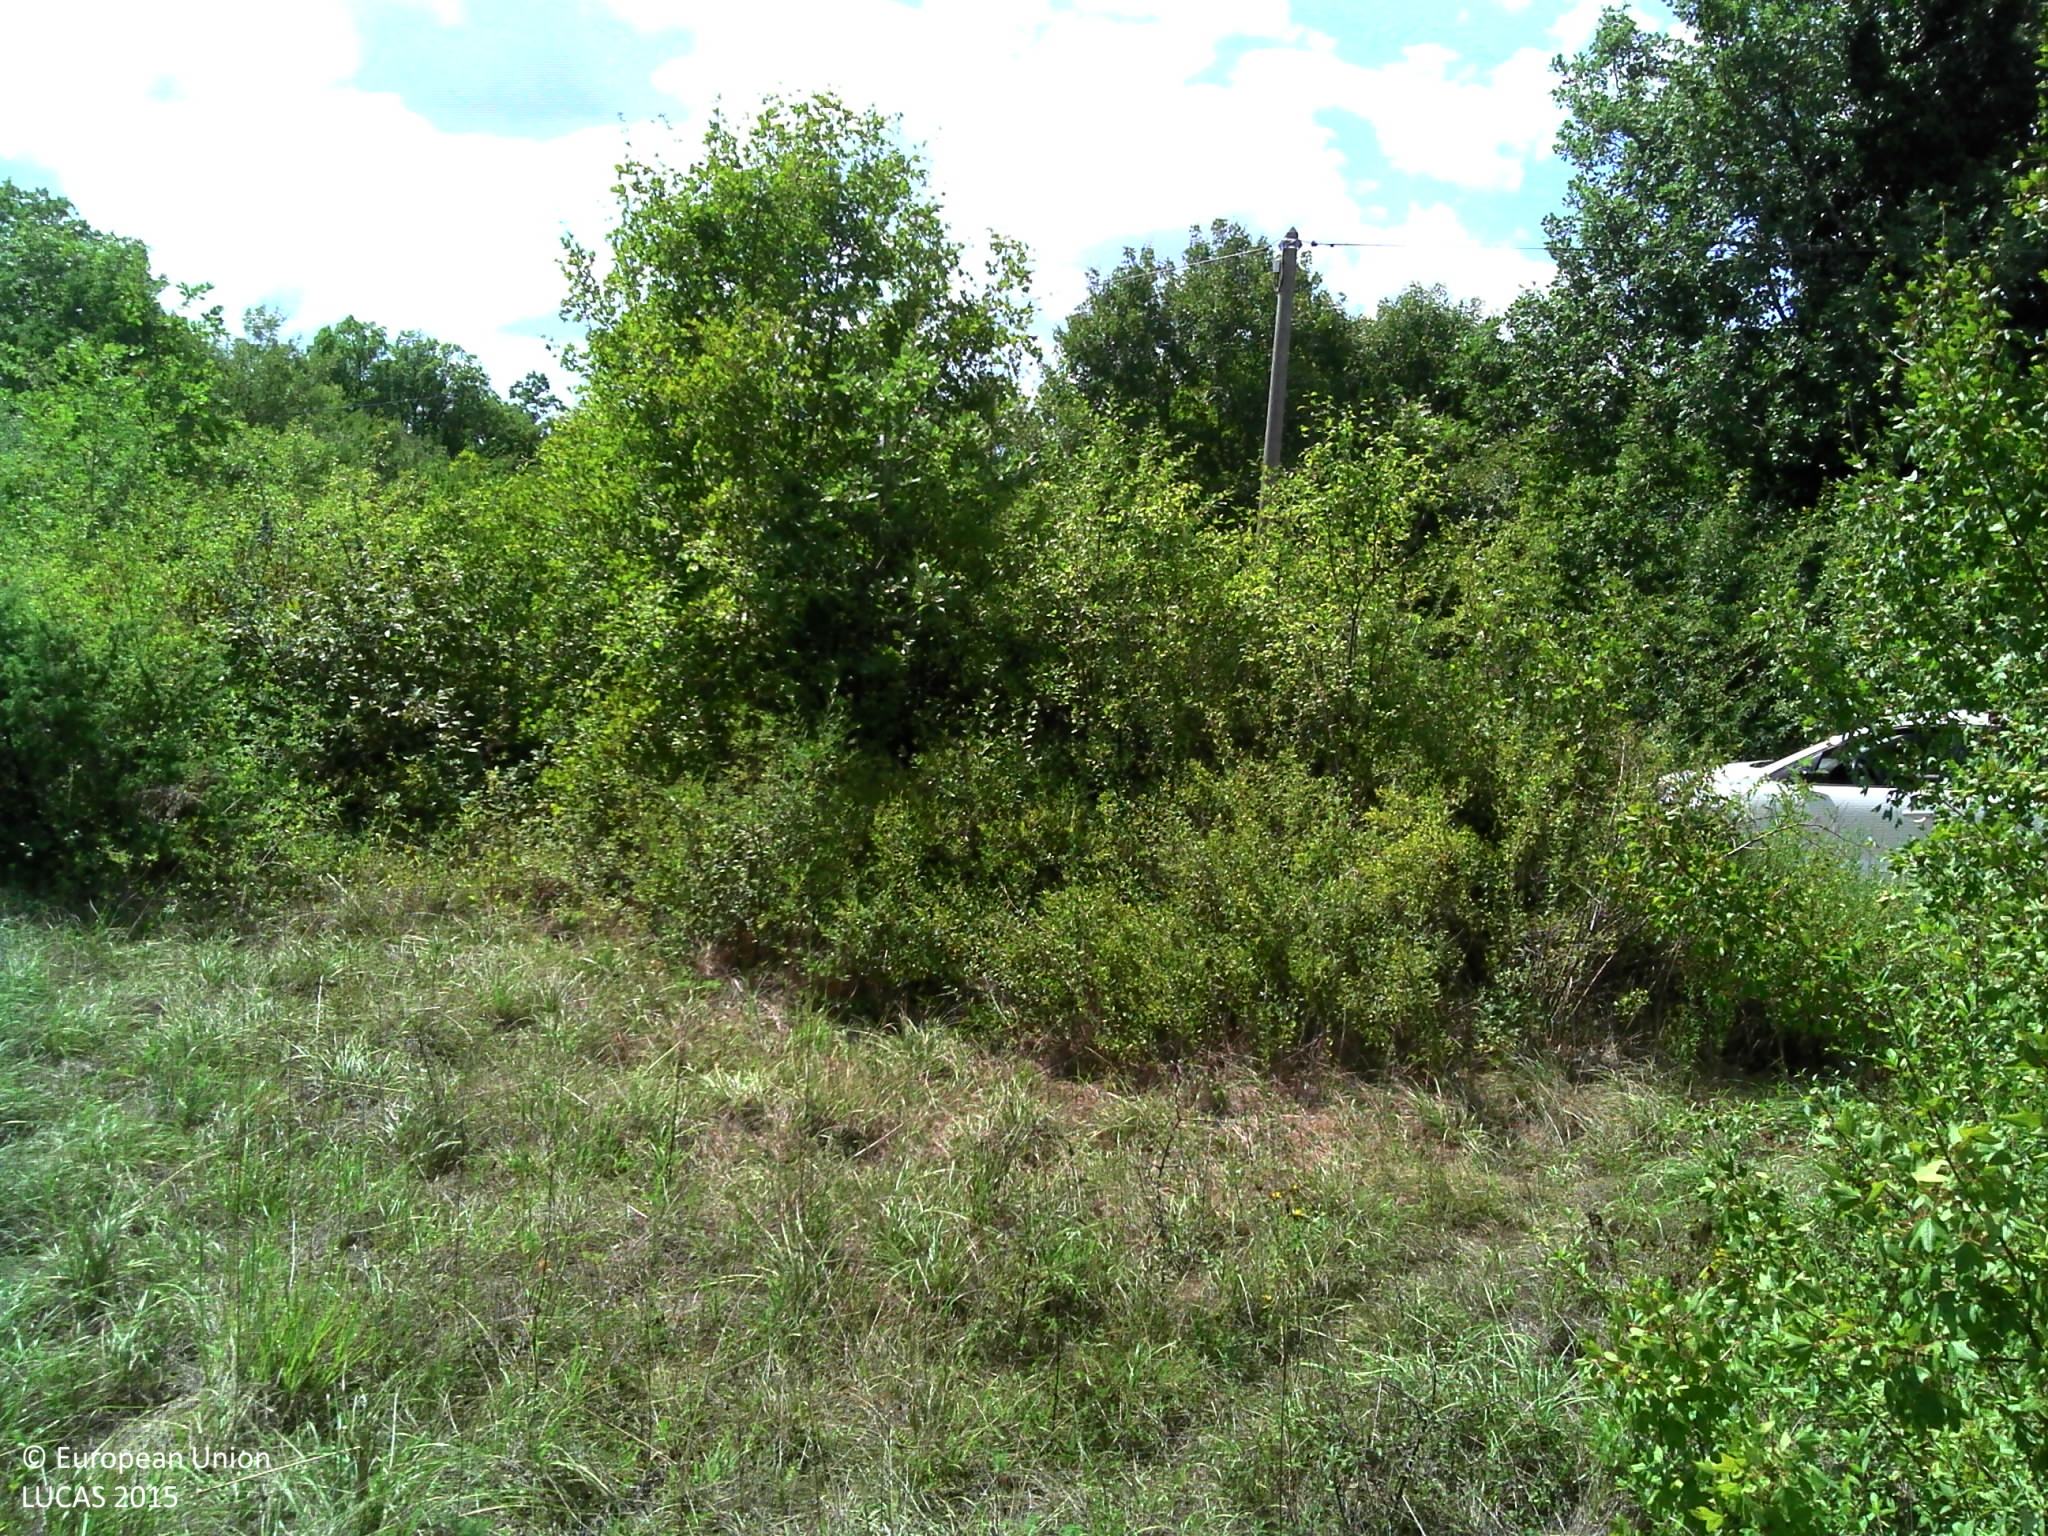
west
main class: Shrubland
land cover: Shrubland with sparse tree cover
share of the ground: > 75 %
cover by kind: shrubs 50 %, herbaceous plants 45 %, broadleaved forest trees 5 %
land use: Semi-natural and natural areas not in use
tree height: < 5 m
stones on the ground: < 10 %
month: August
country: FR
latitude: 44.1236
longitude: 1.6655
